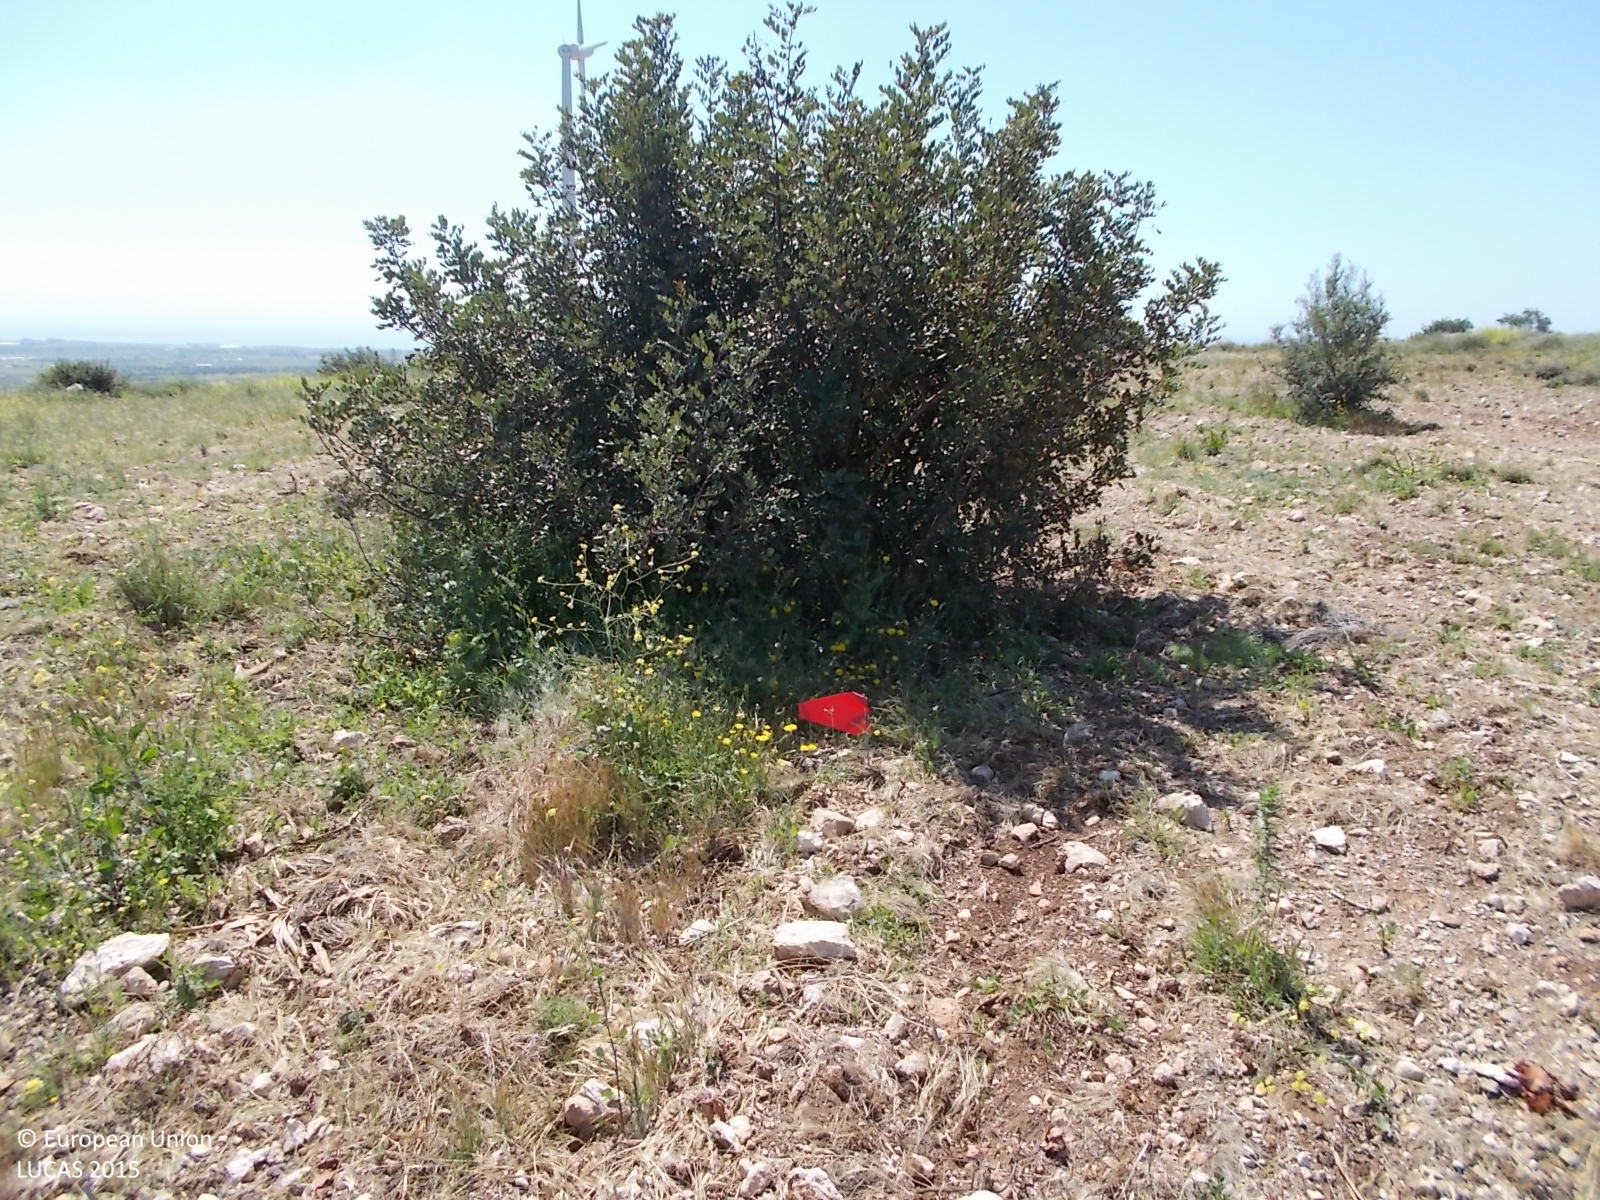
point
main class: Shrubland
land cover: Shrubland without tree cover
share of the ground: 10 - 25 %
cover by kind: unconsolidated bare surface 55 %, herbaceous plants 25 %, shrubs 20 %
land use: Energy production
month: April
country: CY
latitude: 34.8651
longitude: 33.5228
